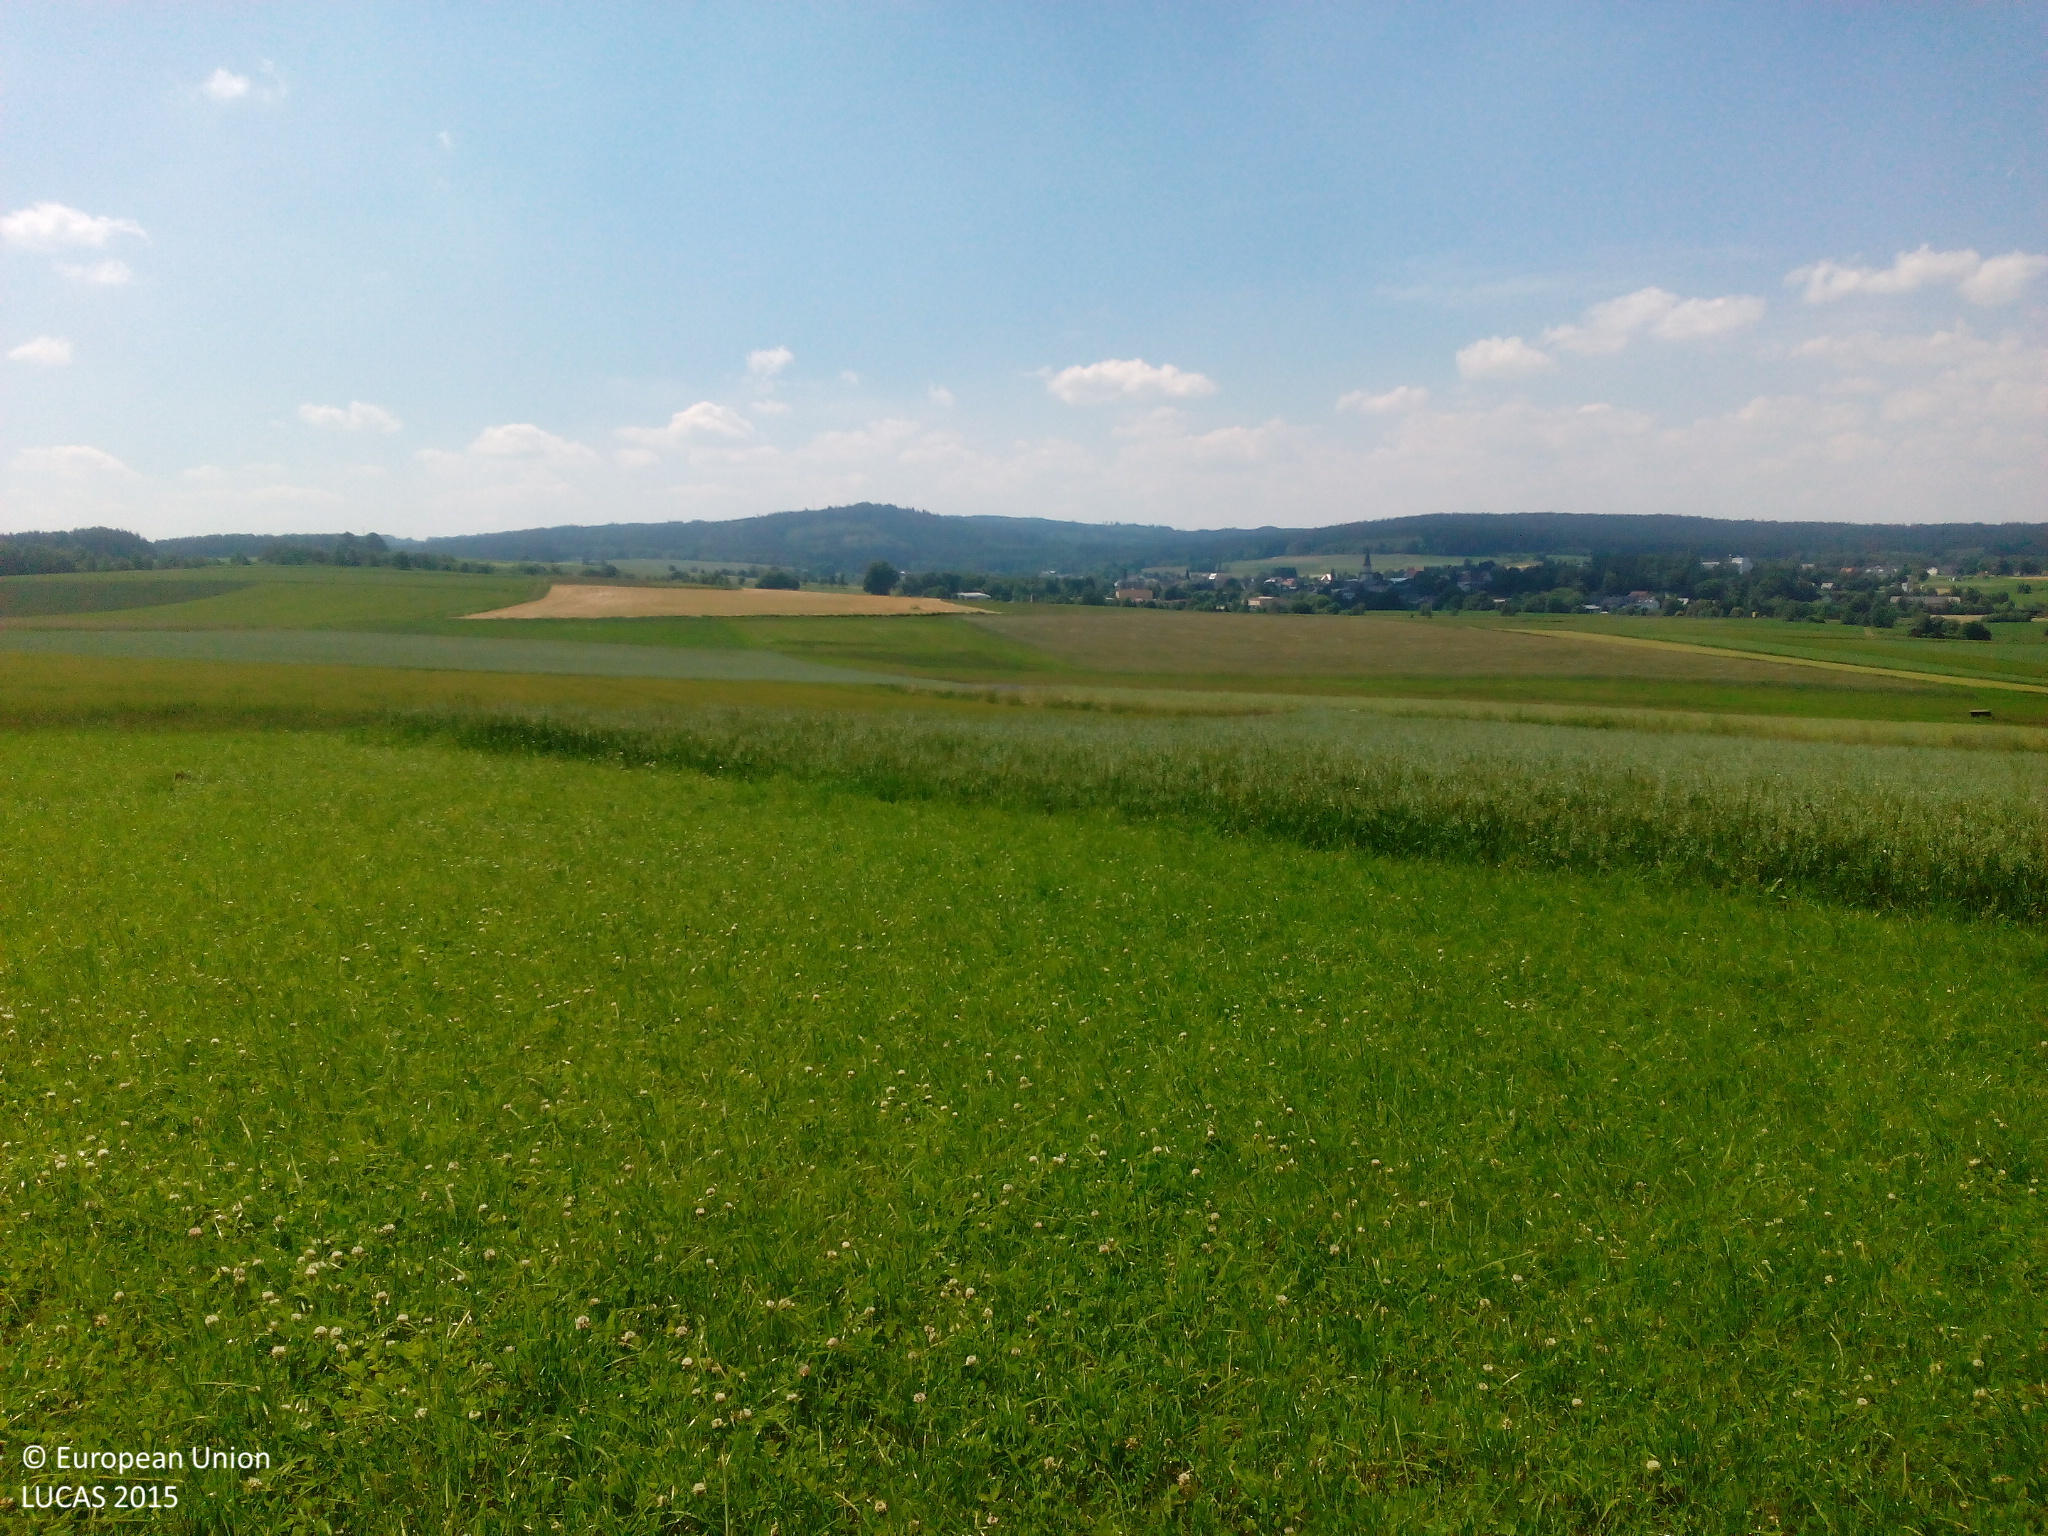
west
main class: Grassland
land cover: Grassland without tree/shrub cover
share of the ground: > 75 %
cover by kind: herbaceous plants 90 %, unconsolidated bare surface 10 %
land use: Agriculture (excluding fallow land and kitchen gardens)
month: June
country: DE
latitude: 50.1492
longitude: 11.9728
